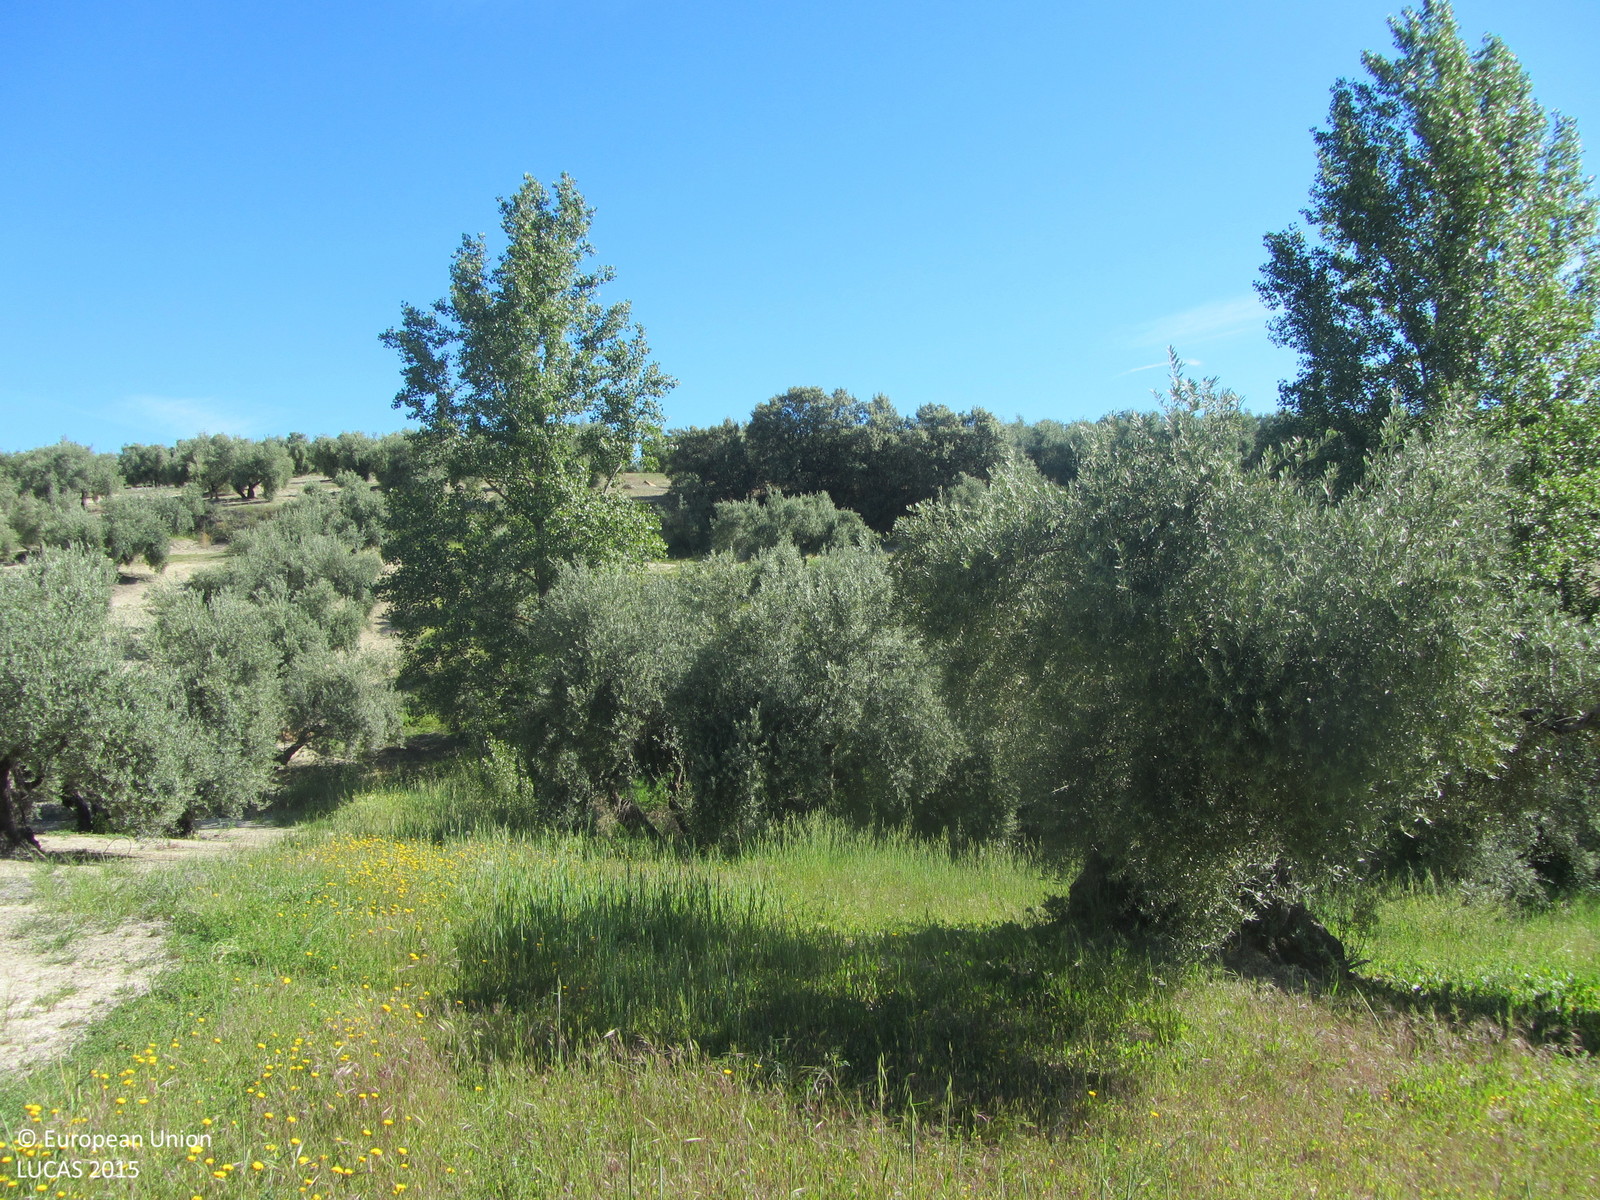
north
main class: Cropland
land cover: Olive groves
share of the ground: 25 - 50 %
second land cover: Spontaneously vegetated surfaces
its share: > 75 %
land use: Agriculture (excluding fallow land and kitchen gardens)
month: May
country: ES
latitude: 38.1116
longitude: -3.0345
